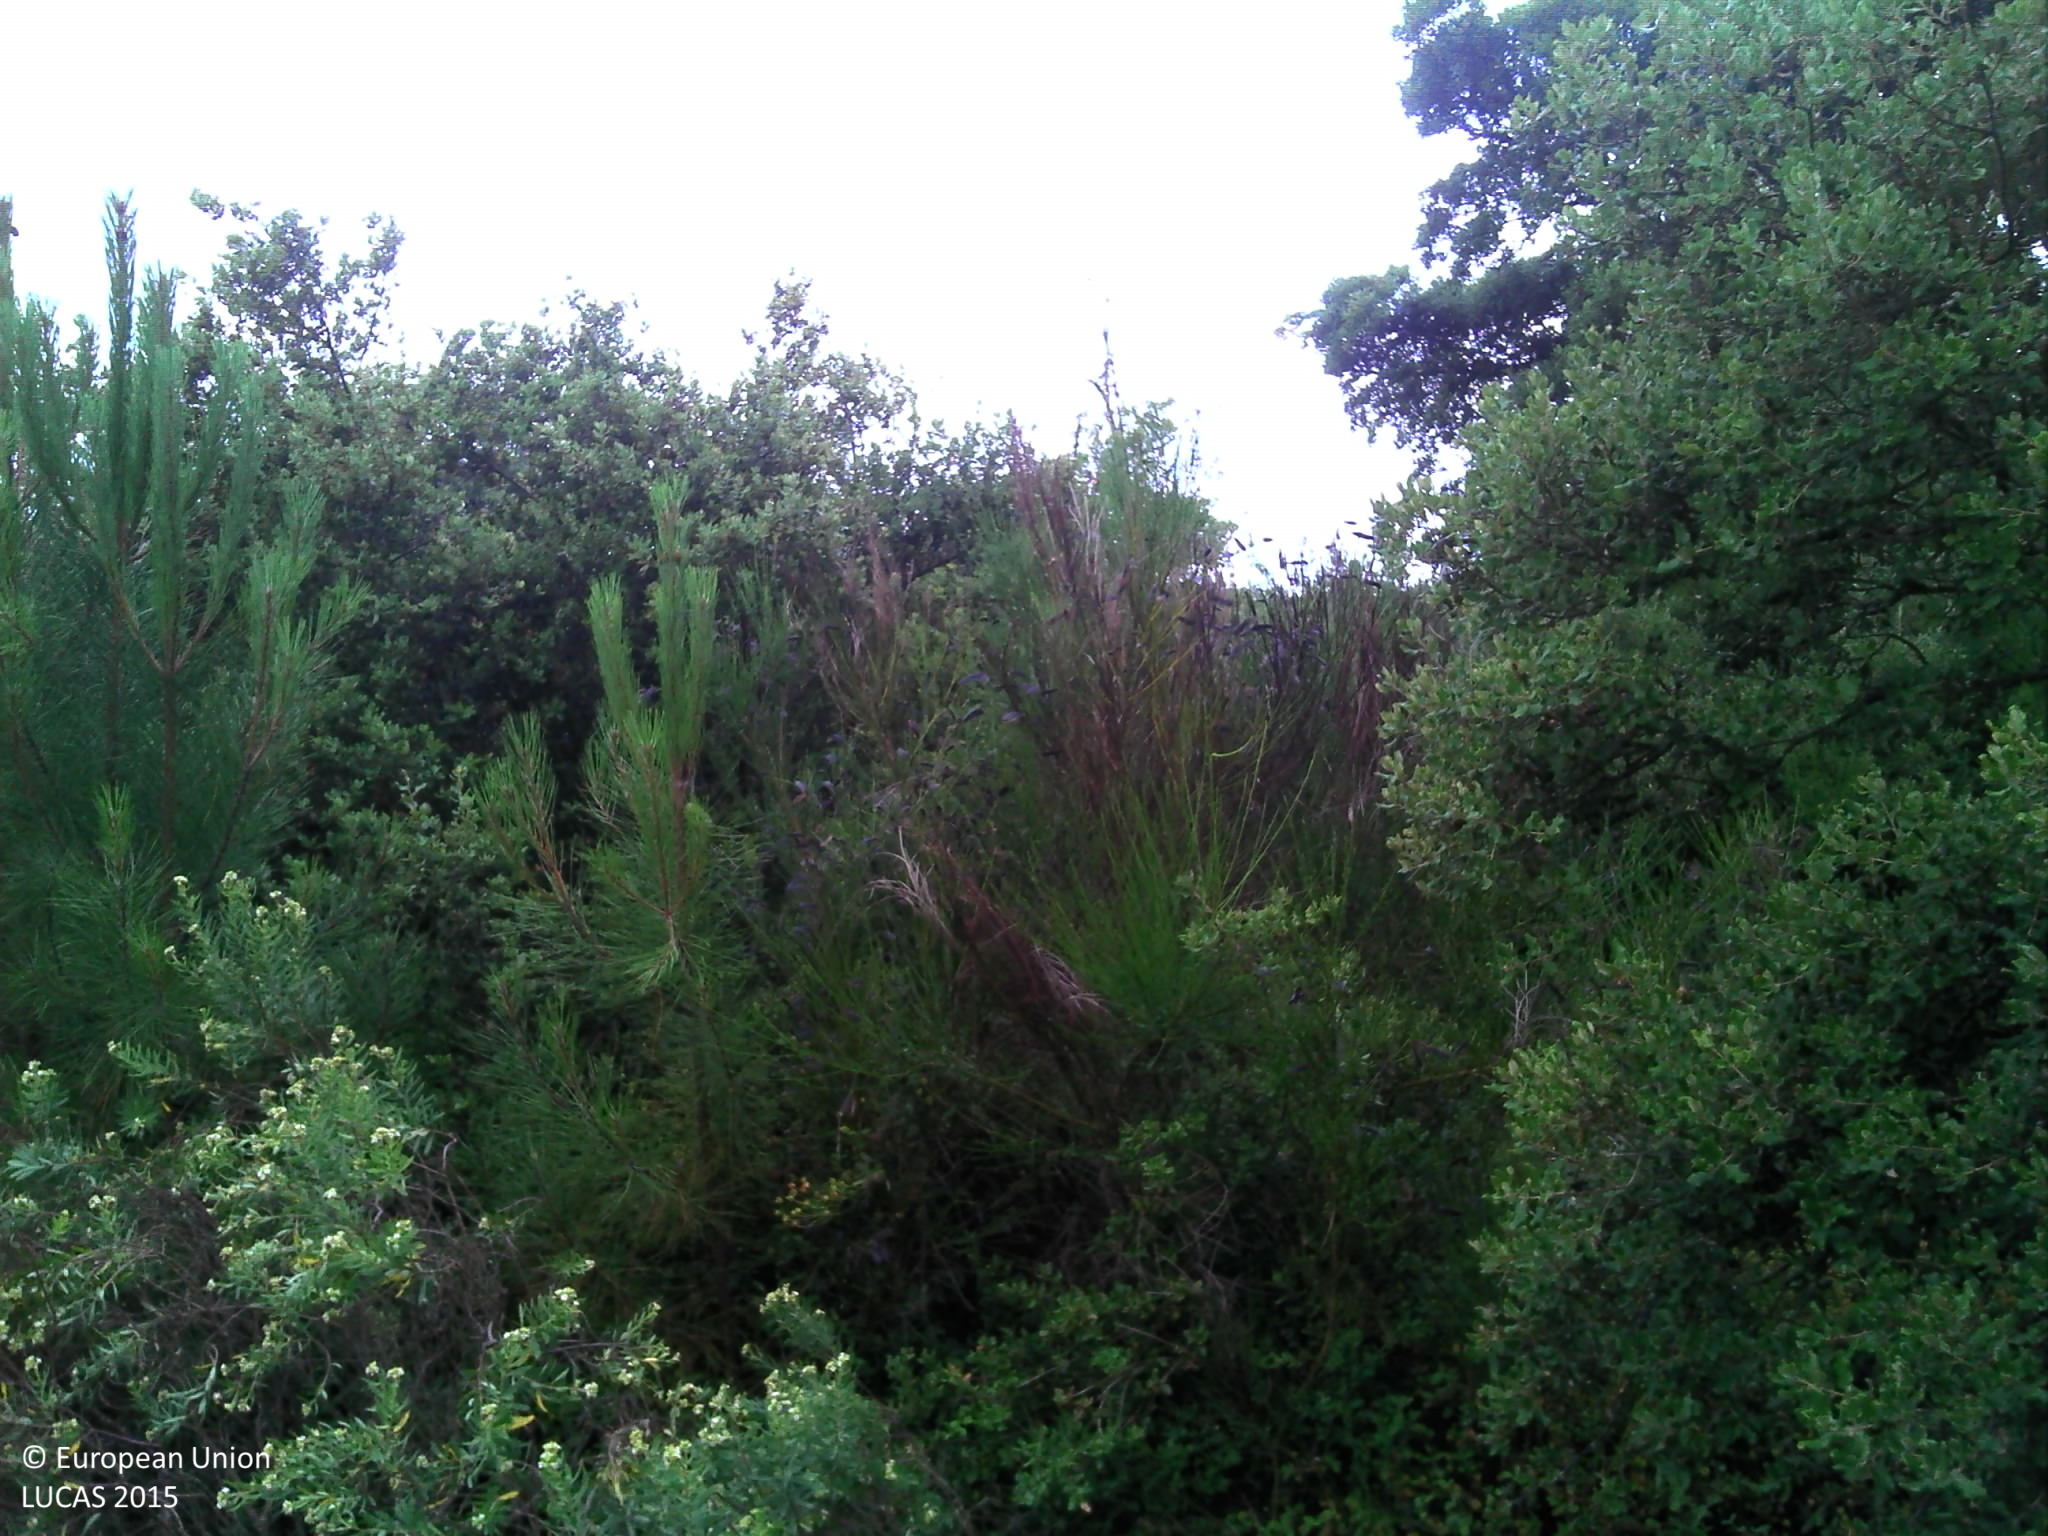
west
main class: Woodland
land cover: Pine dominated mixed woodland
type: coniferous forest of the mediterranean region
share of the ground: > 75 %
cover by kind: coniferous forest trees 75 %, broadleaved forest trees 25 %
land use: Forestry
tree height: > 5 m
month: June
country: FR
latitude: 45.6593
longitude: -1.1303
